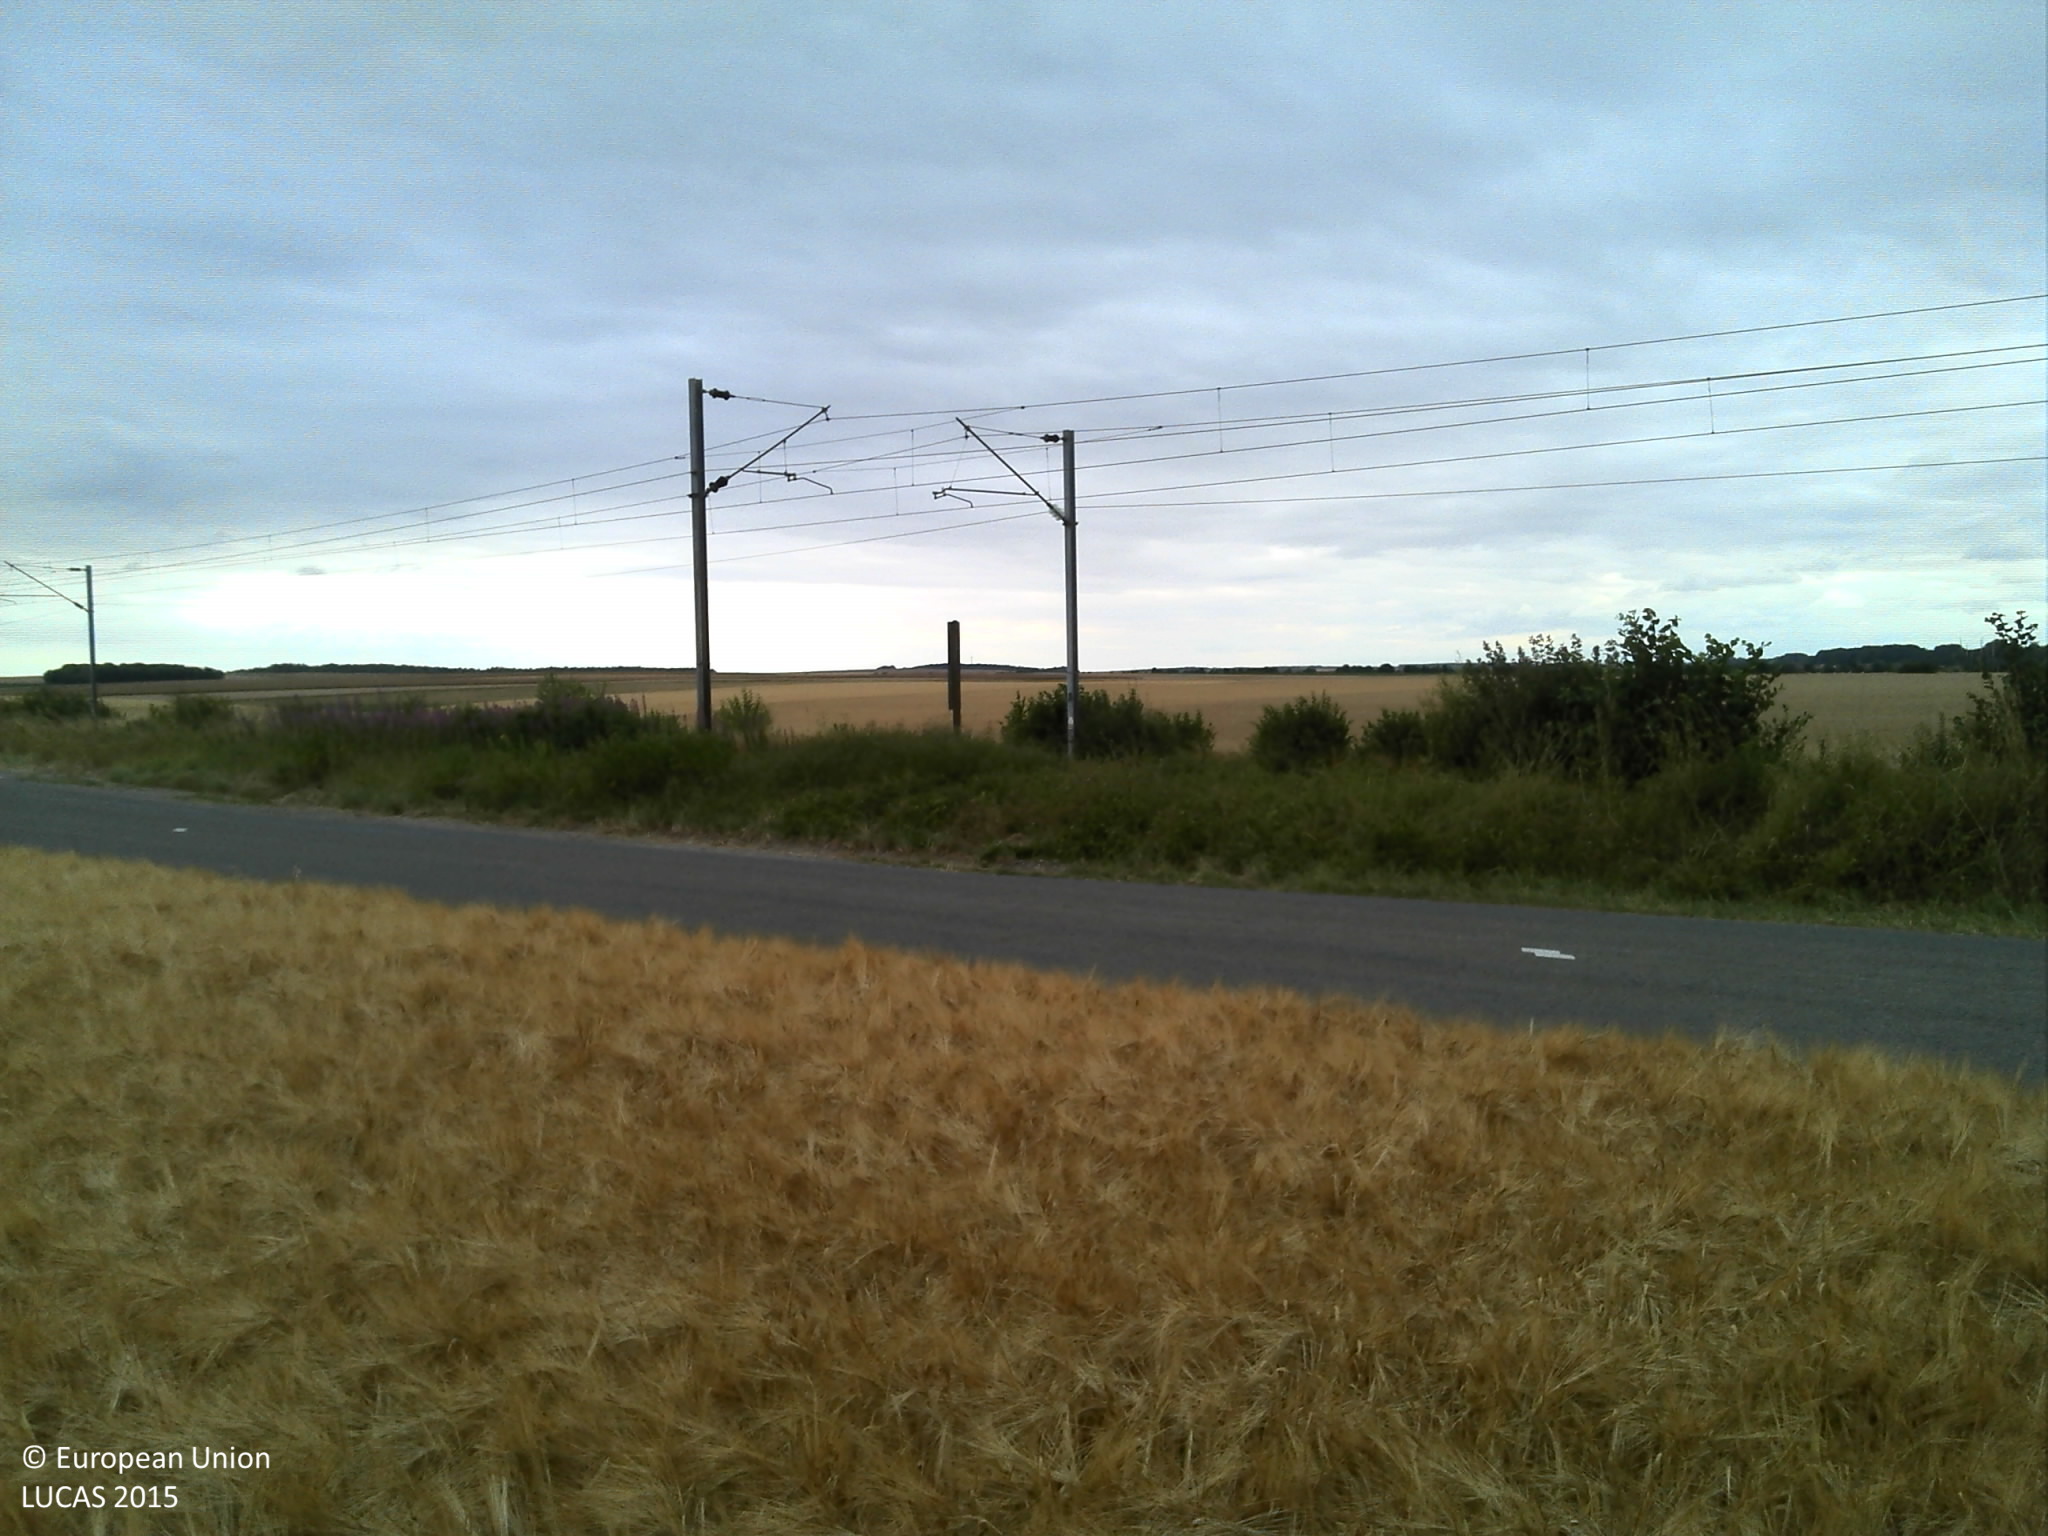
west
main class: Cropland
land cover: Barley
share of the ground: > 75 %
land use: Agriculture (excluding fallow land and kitchen gardens)
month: July
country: FR
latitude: 49.4094
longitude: 4.2759
